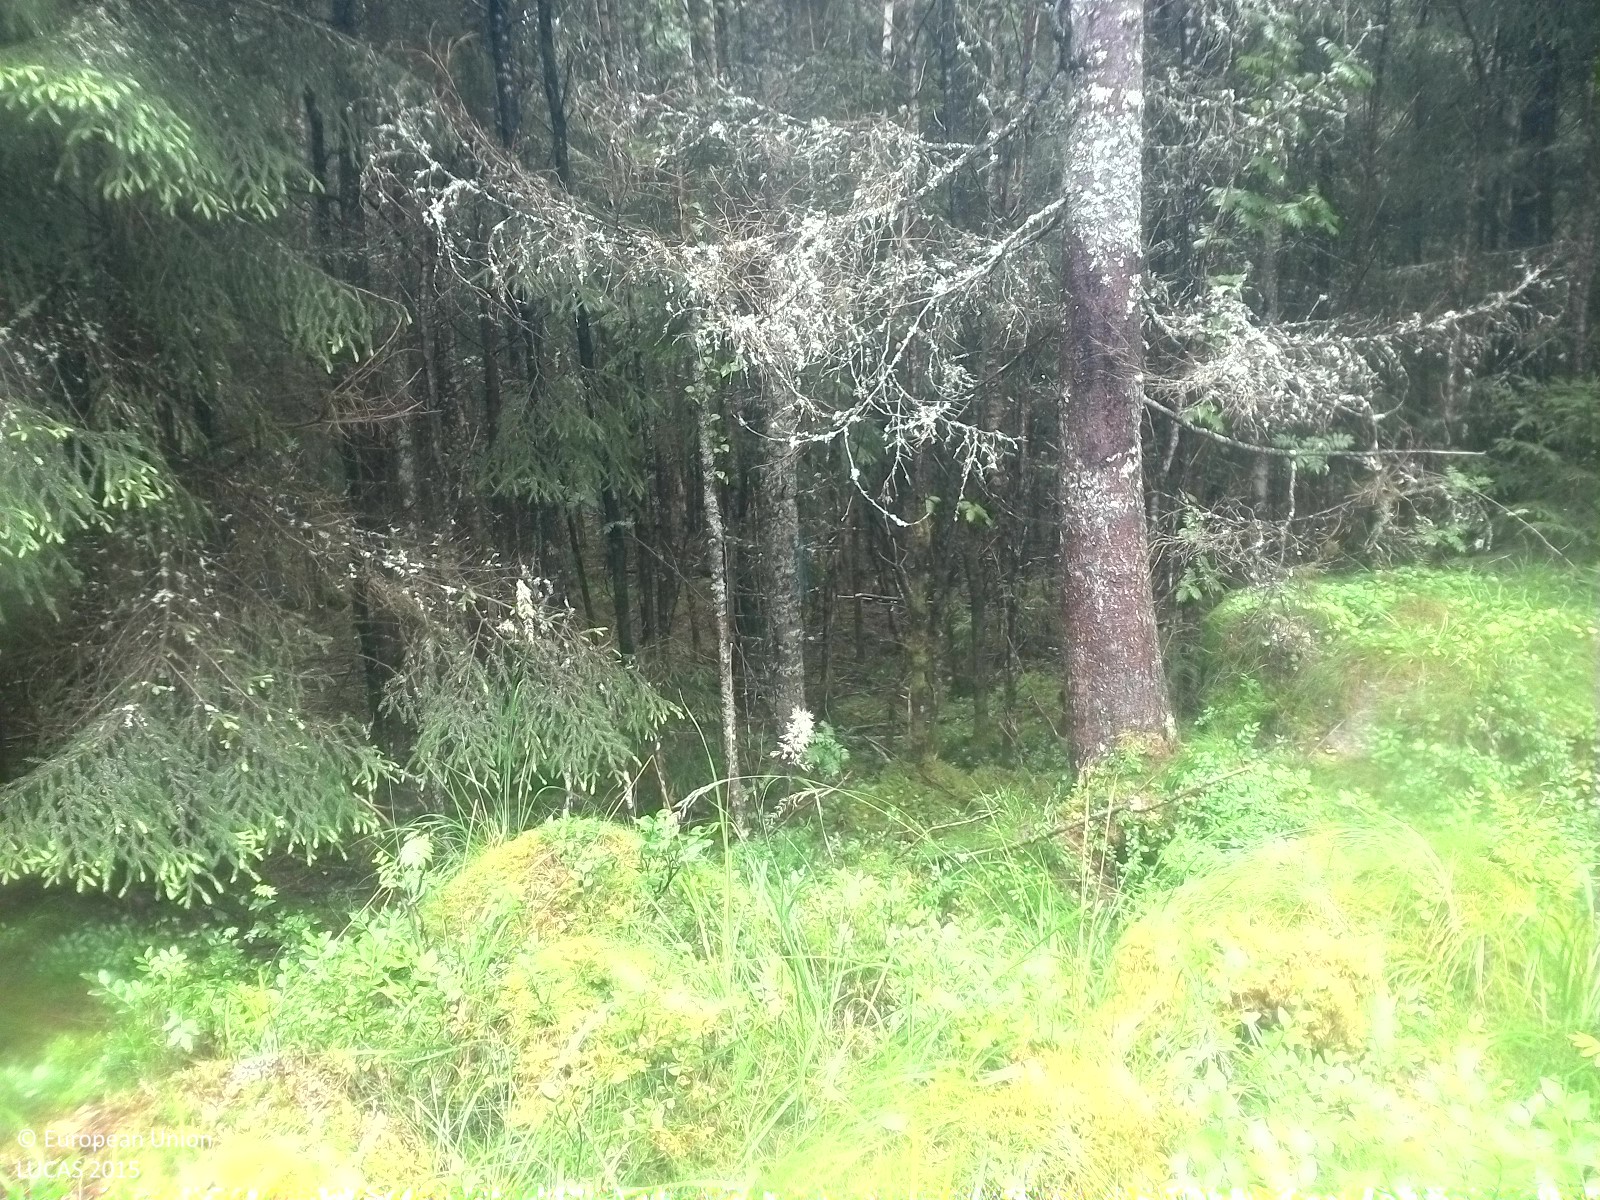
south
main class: Woodland
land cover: Spruce dominated mixed woodland
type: boreal forest
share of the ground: 25 - 50 %
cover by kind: herbaceous plants 55 %, coniferous forest trees 20 %, broadleaved forest trees 15 %, lichens and mosses 10 %
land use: Forestry
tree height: > 5 m
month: July
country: SE
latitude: 58.8463
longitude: 15.0359
